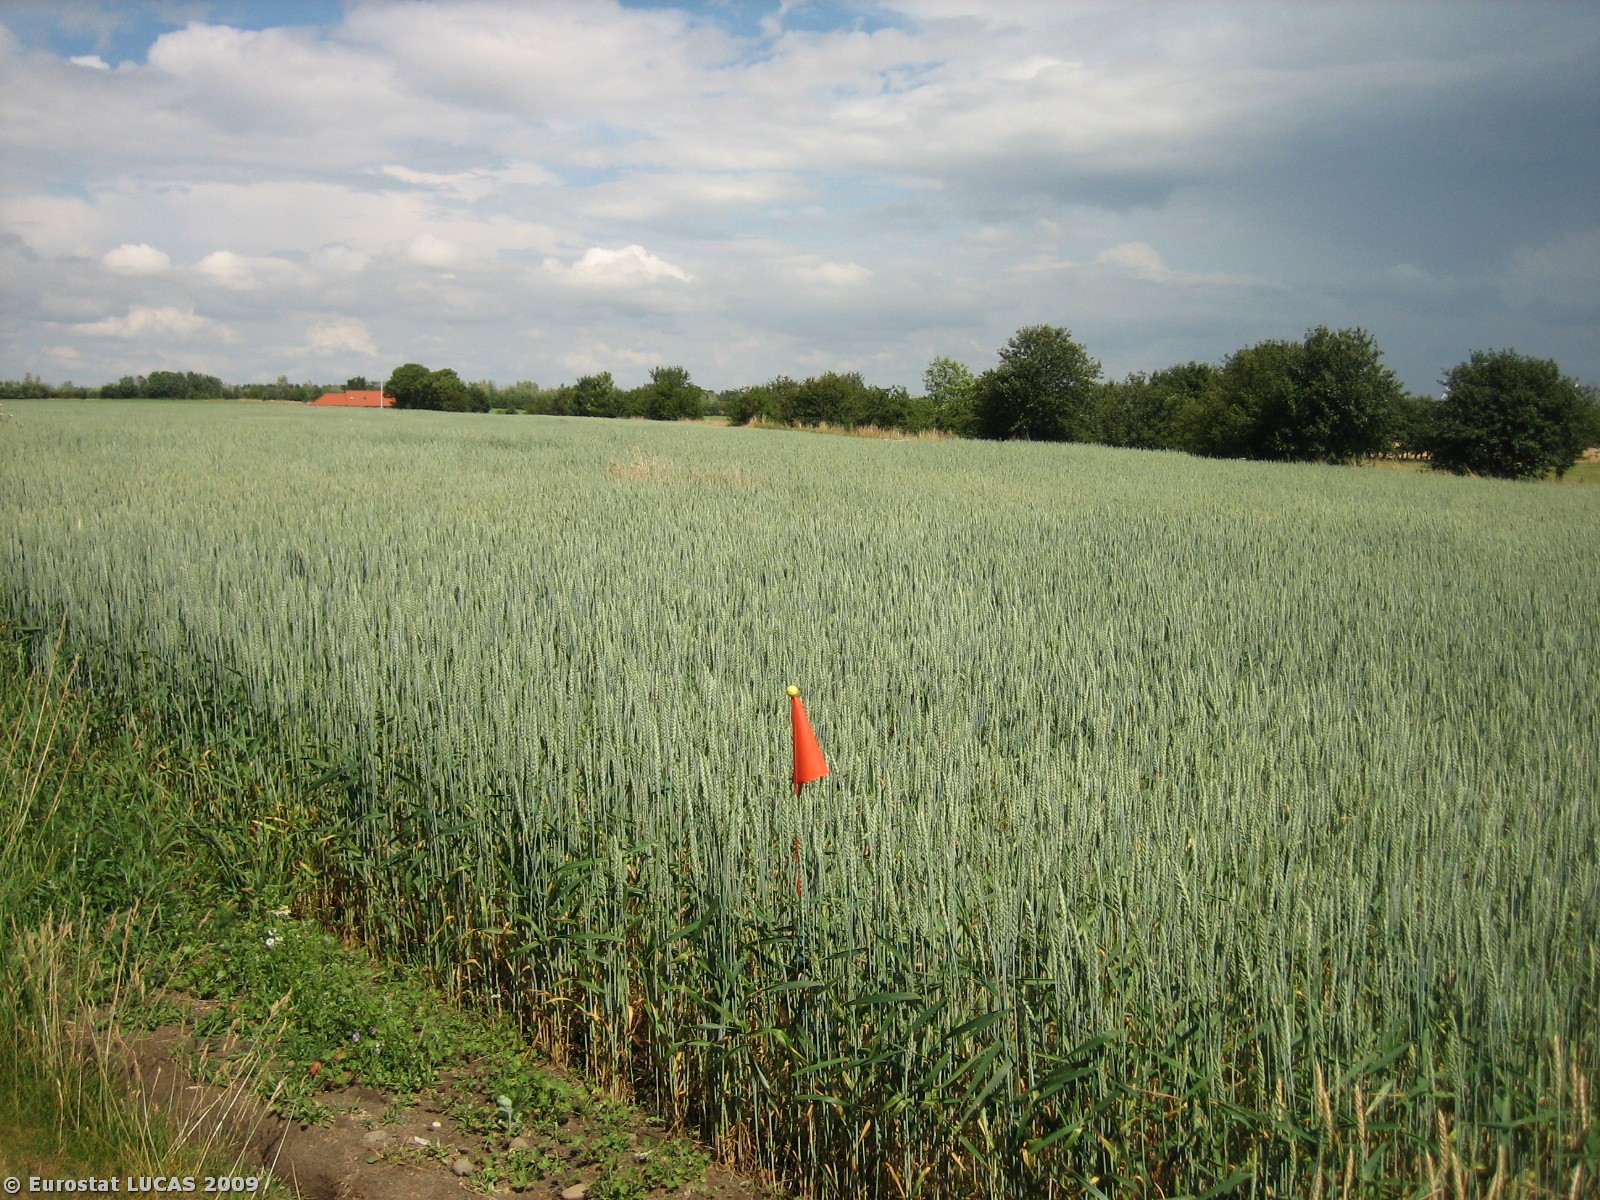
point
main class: Cropland
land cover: Common wheat
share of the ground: > 75 %
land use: Agriculture (excluding fallow land and kitchen gardens)
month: July
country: DK
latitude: 55.6070
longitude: 8.8106
